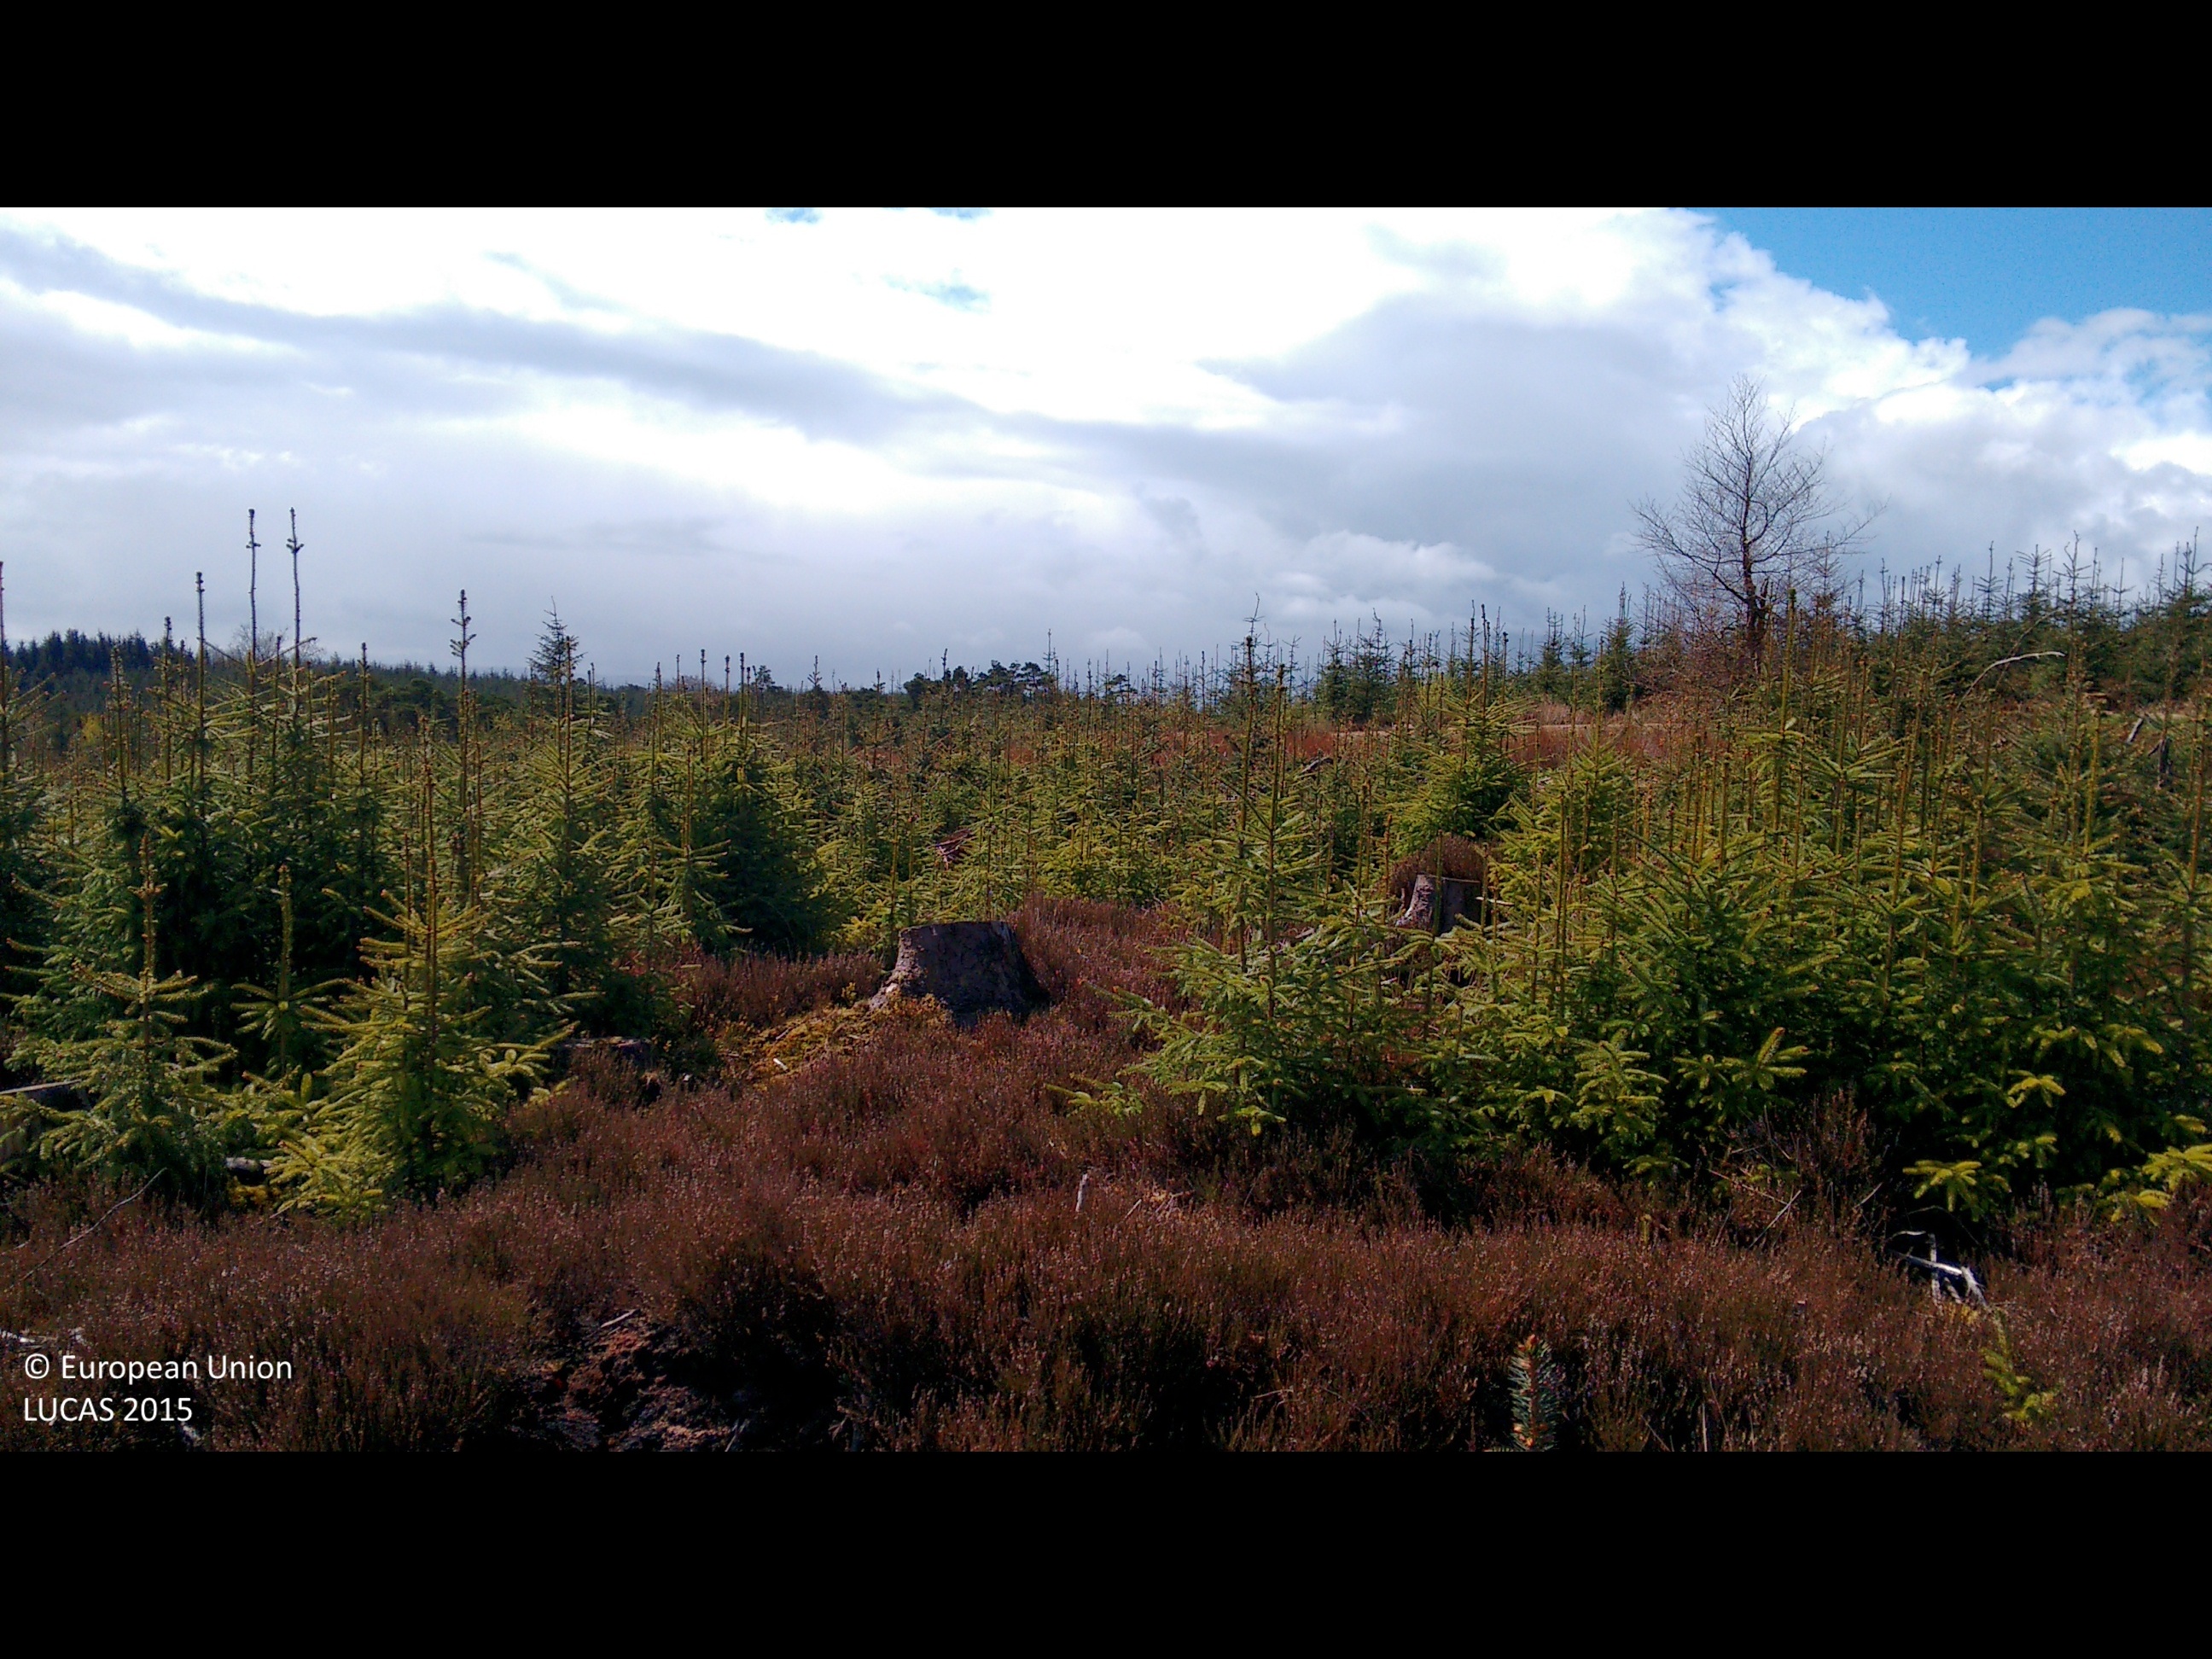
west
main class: Woodland
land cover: Spruce dominated coniferous woodland
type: exotic forest
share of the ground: 25 - 50 %
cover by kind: coniferous forest trees 50 %, herbaceous plants 35 %, shrubs 15 %
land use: Forestry
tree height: < 5 m
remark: Clear cut
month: April
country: GB
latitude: 53.8597
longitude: -2.5178
